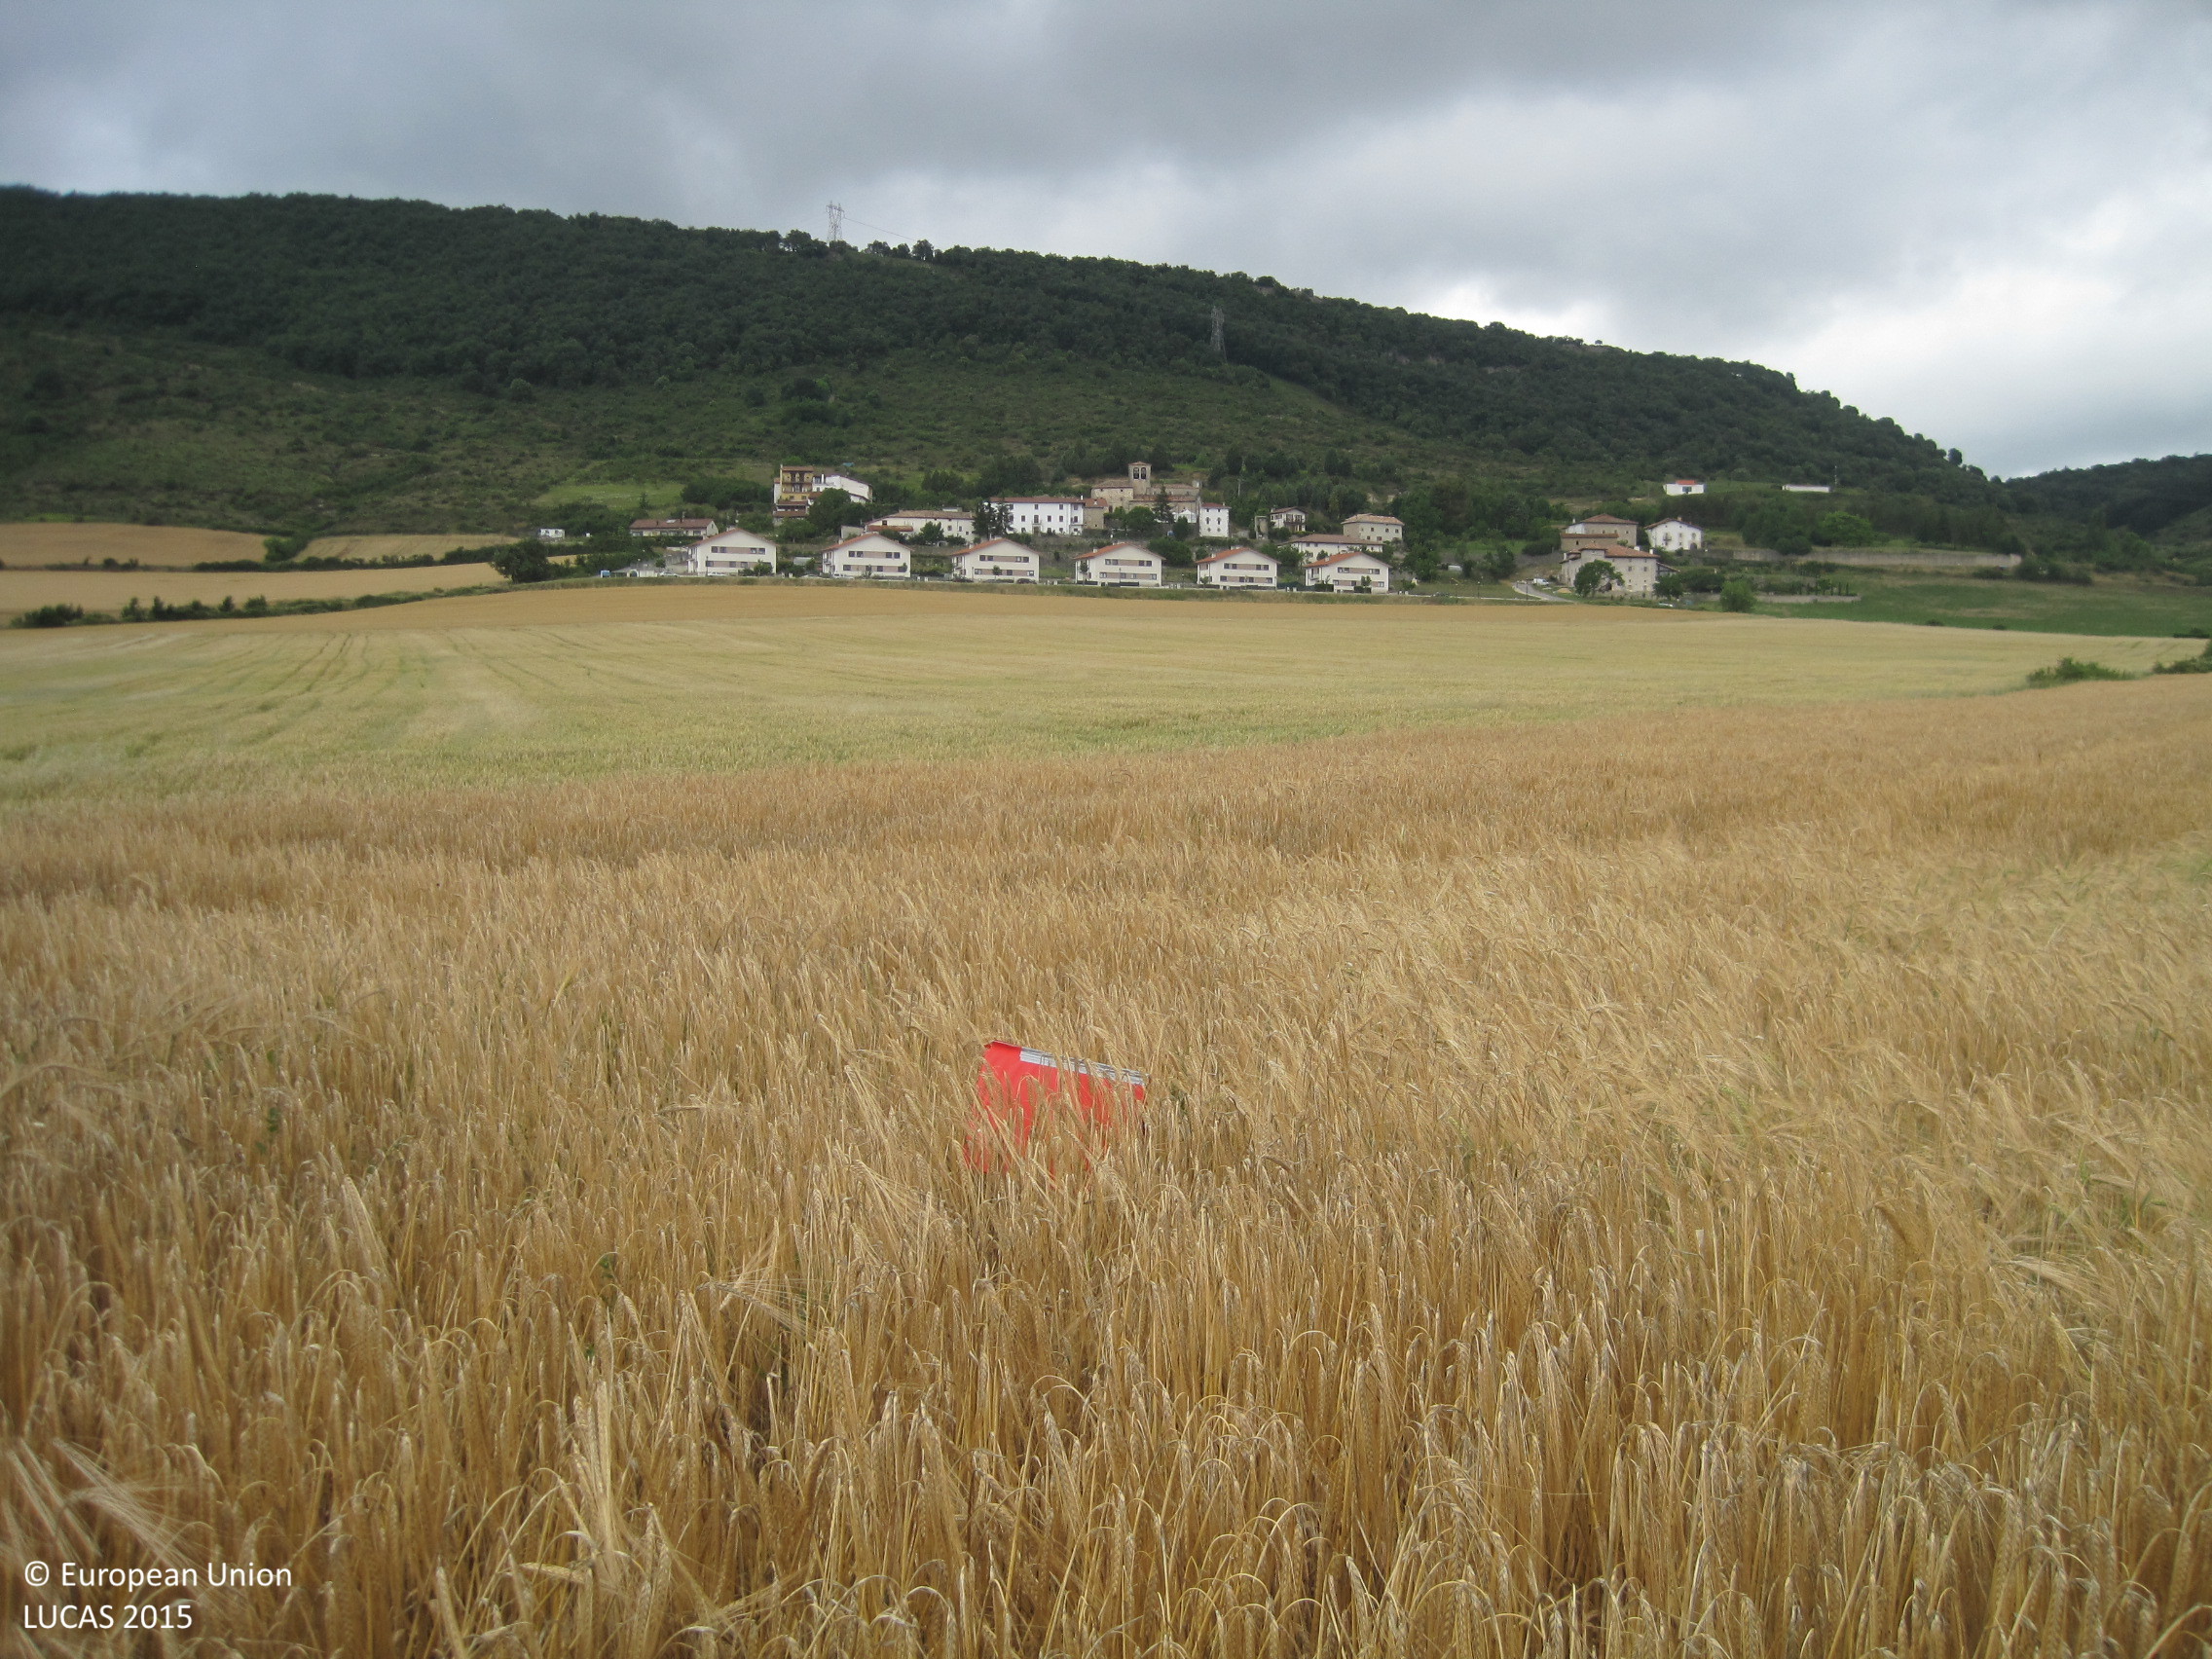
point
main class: Cropland
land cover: Barley
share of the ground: > 75 %
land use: Agriculture (excluding fallow land and kitchen gardens)
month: June
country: ES
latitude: 42.8753
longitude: -1.7811
